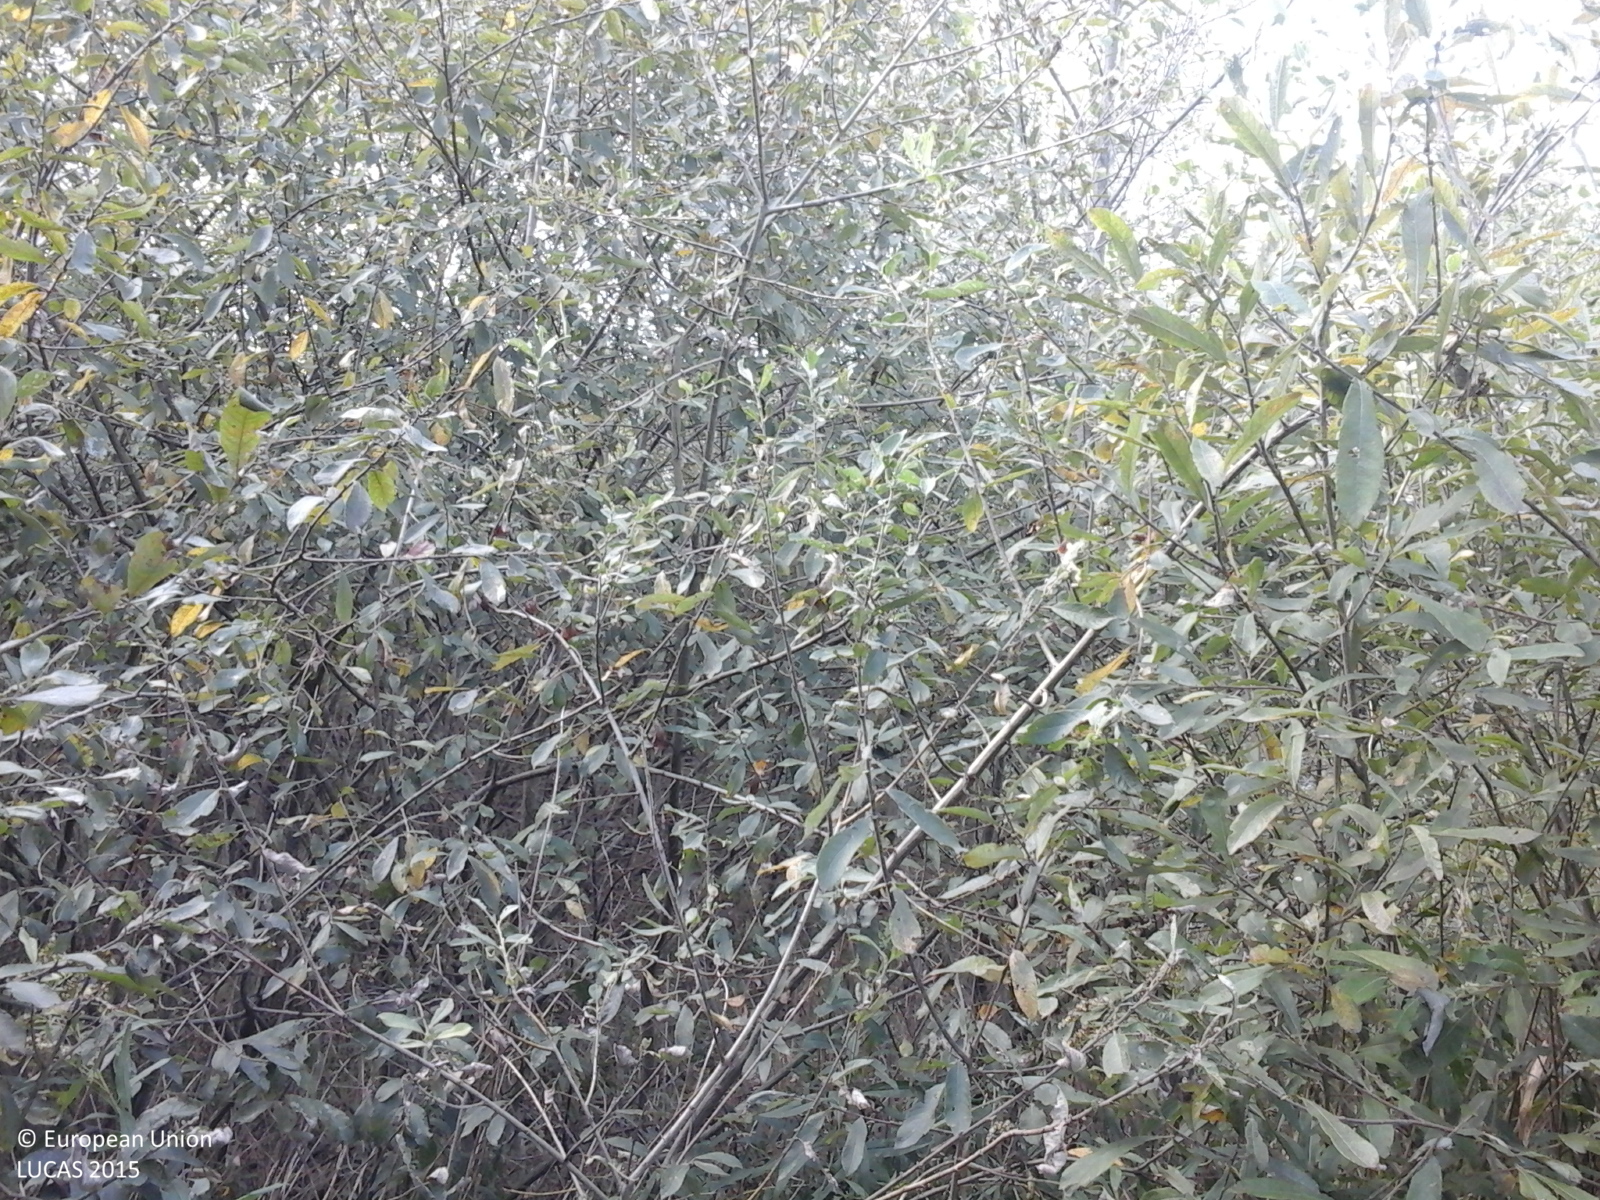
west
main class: Woodland
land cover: Broadleaved woodland
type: non-riverine alder, birch or aspen forest
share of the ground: > 75 %
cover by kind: broadleaved forest trees 100 %
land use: Semi-natural and natural areas not in use
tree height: < 5 m
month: September
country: RO
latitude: 45.5086
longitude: 22.1619
